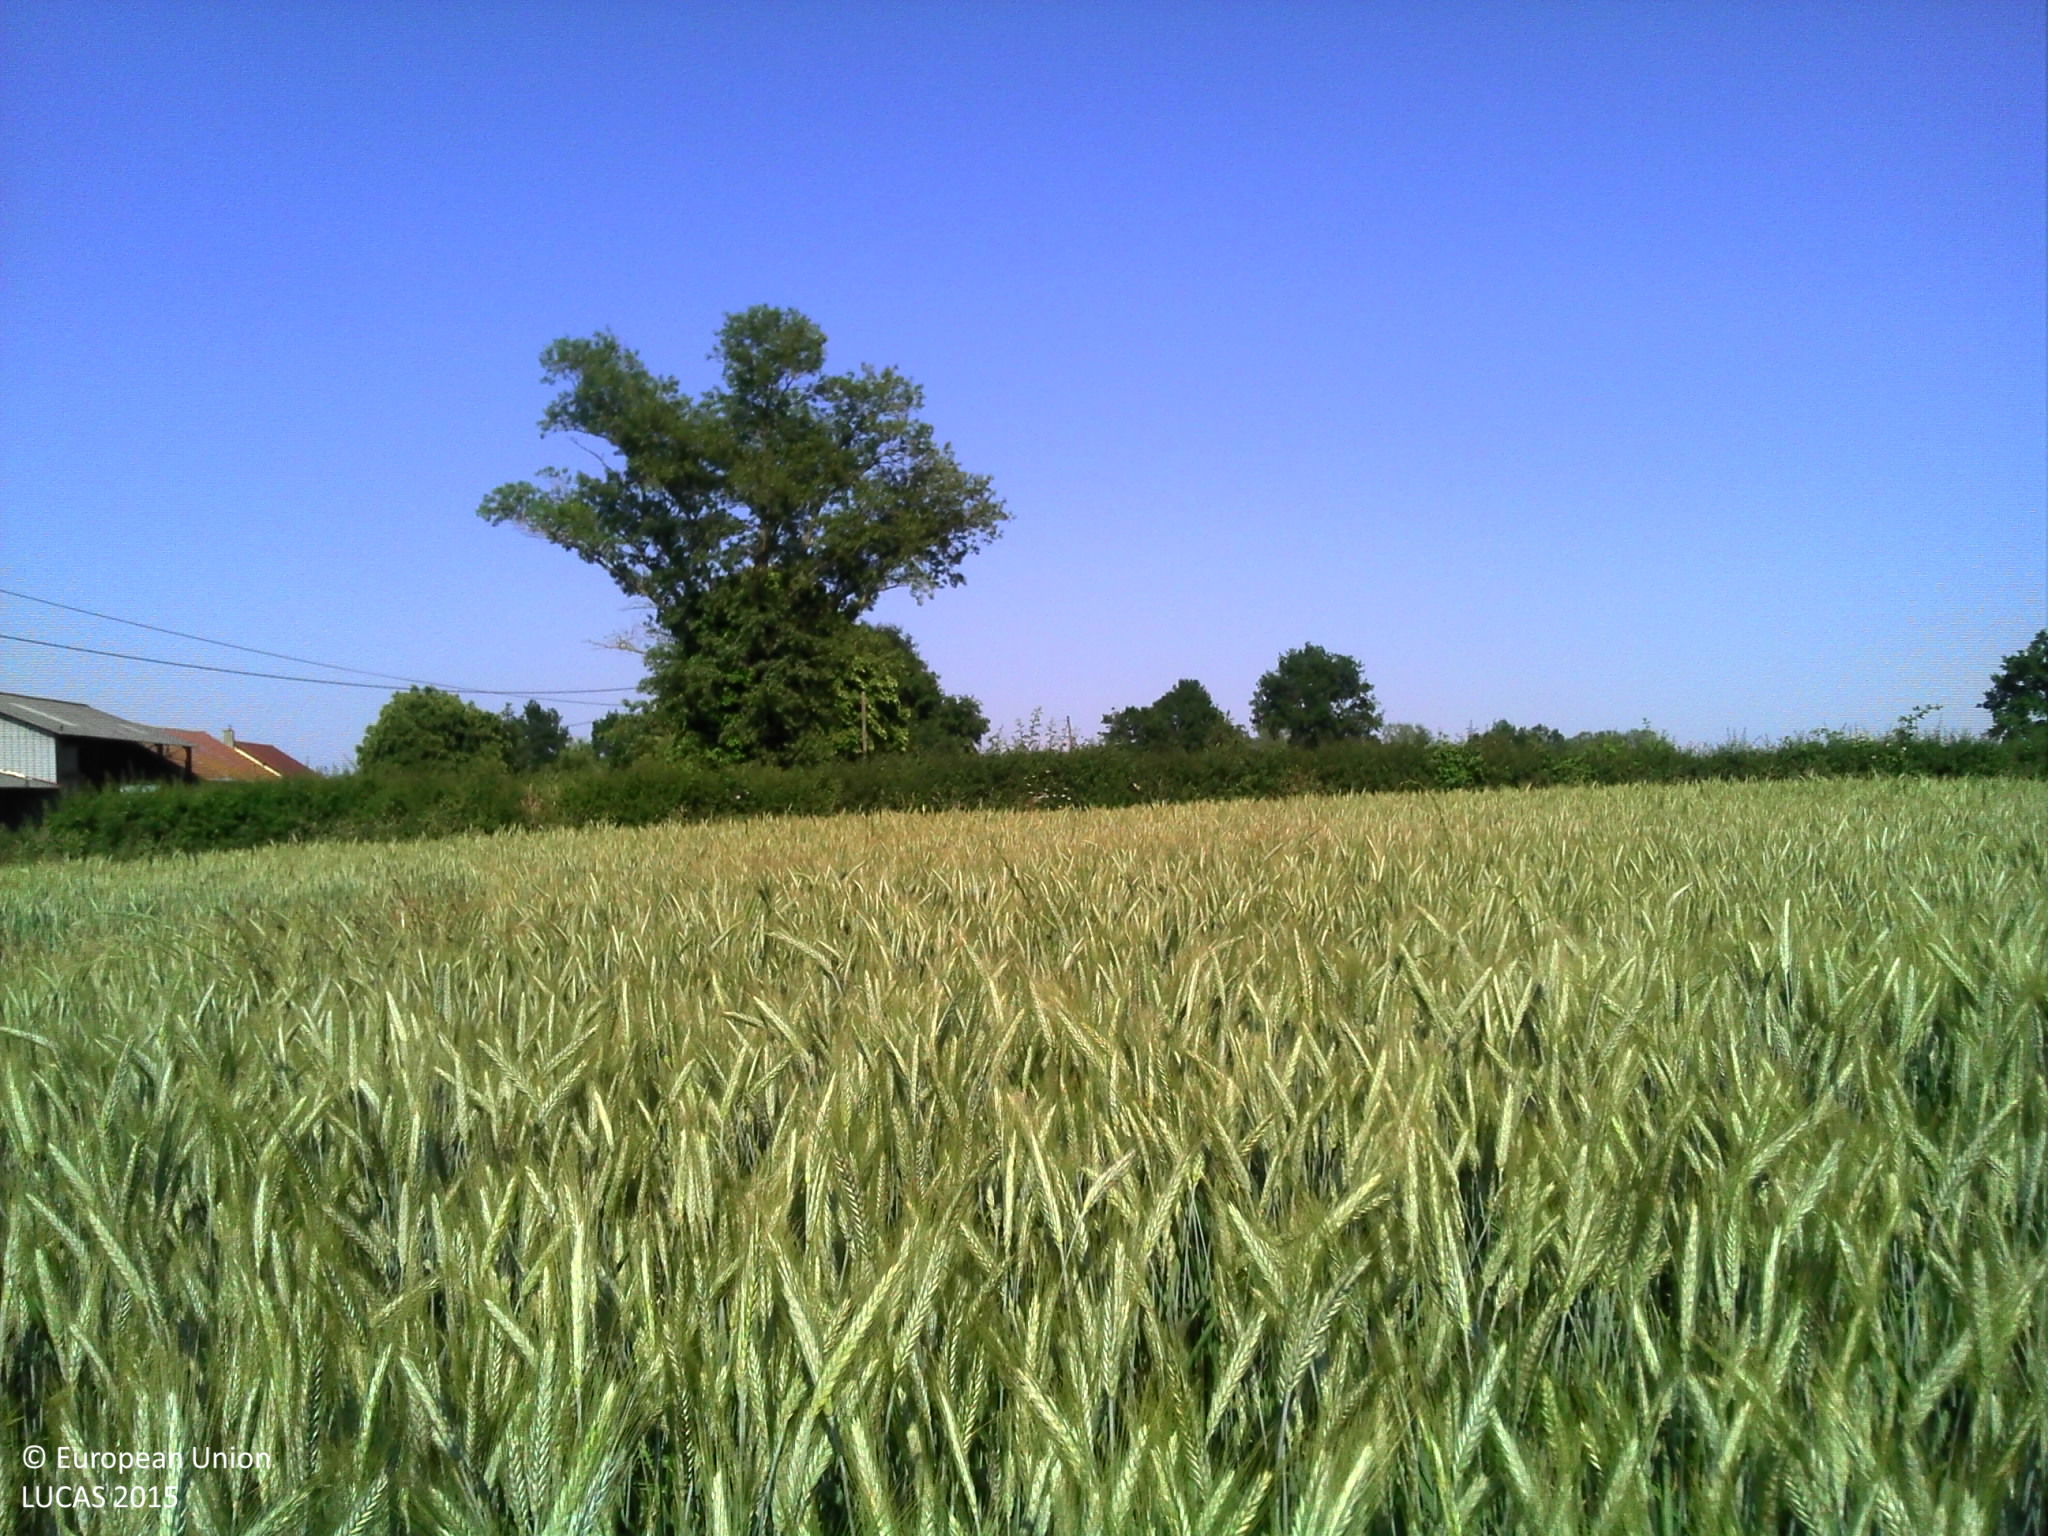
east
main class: Cropland
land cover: Common wheat
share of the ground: > 75 %
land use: Agriculture (excluding fallow land and kitchen gardens)
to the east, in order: Common wheat; Fences; Managed hedges; Grass margins; Tracks; Grass margins; Managed hedges; Fences; Grassland without tree/shrub cover; Fences; Managed hedges; Common wheat; Fences; Managed hedges; Ditches and canals; Grass margins; Paved roads, cycling and walking lanes; Grass margins; Ditches and canals; Managed hedges; Grassland without tree/shrub cover
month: June
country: FR
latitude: 46.4268
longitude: 2.6960
